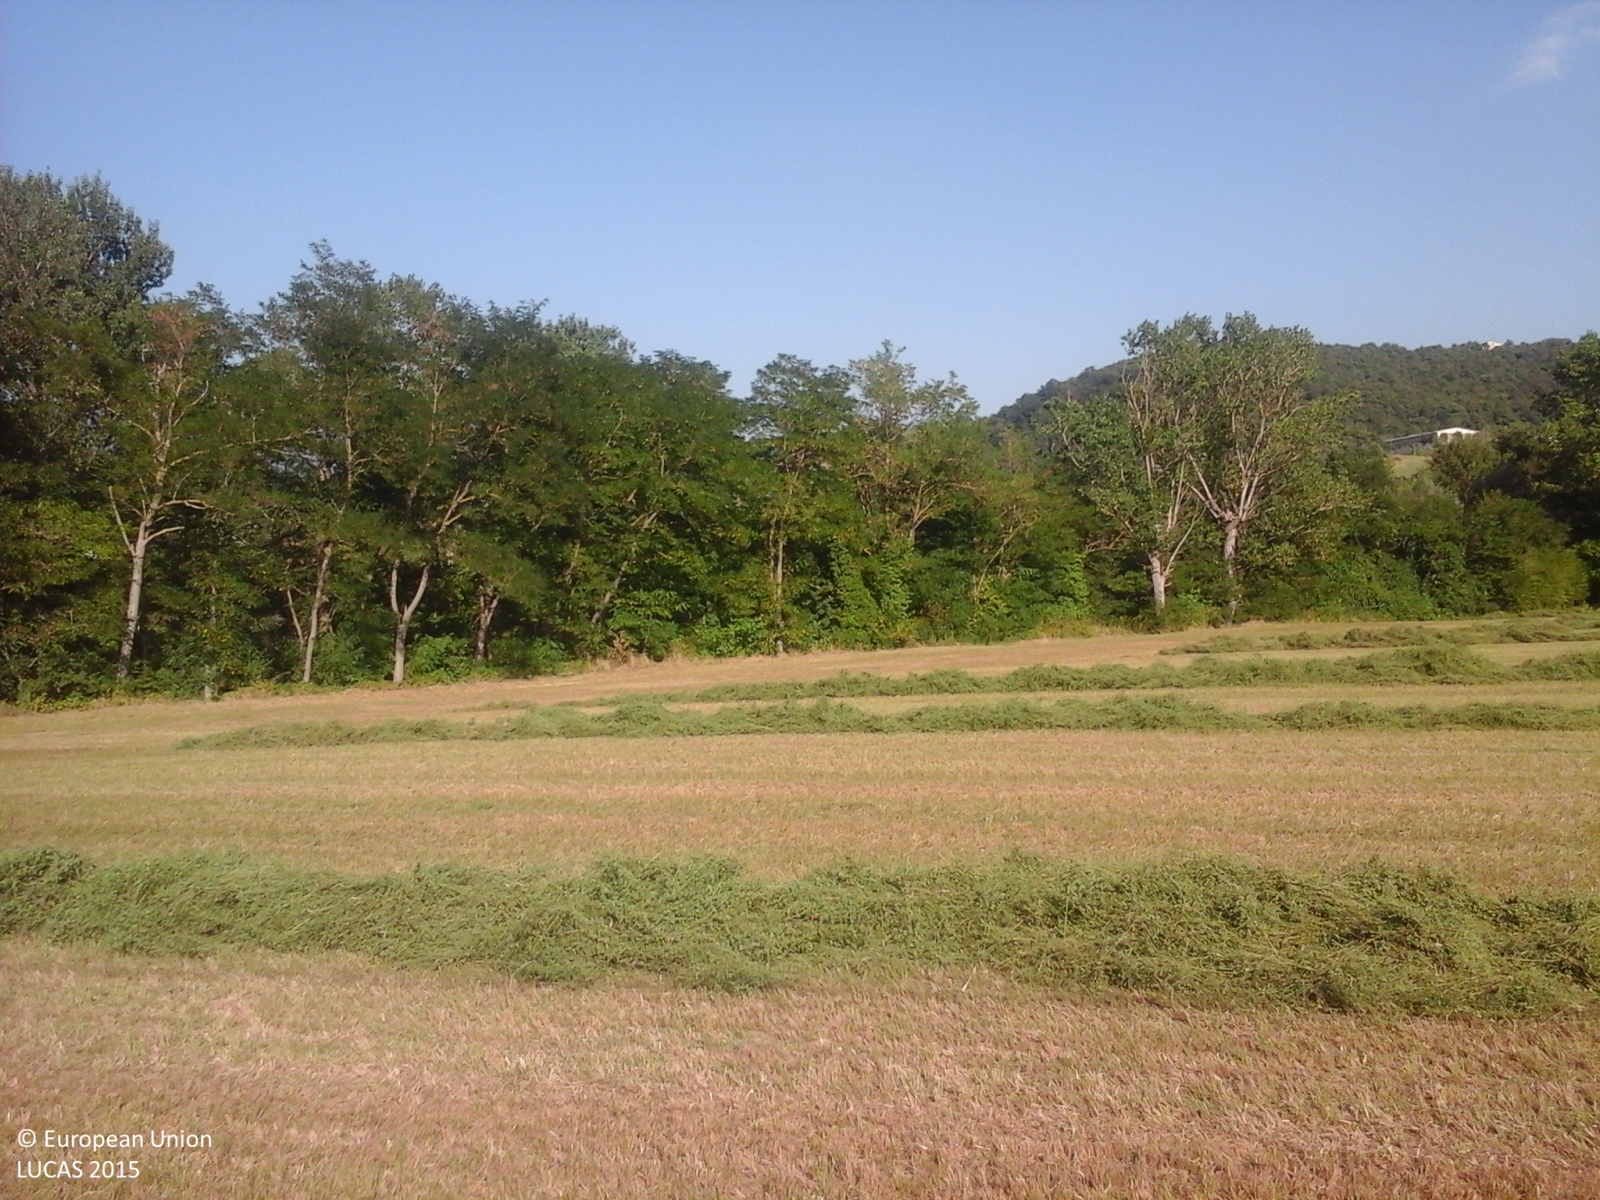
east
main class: Cropland
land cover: Lucerne
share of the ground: > 75 %
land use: Agriculture (excluding fallow land and kitchen gardens)
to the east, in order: Lucerne; Broadleaved woodland; Inland fresh running water; Broadleaved woodland; Grassland without tree/shrub cover; Shrubland without tree cover
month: August
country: IT
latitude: 43.6126
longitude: 12.6572
